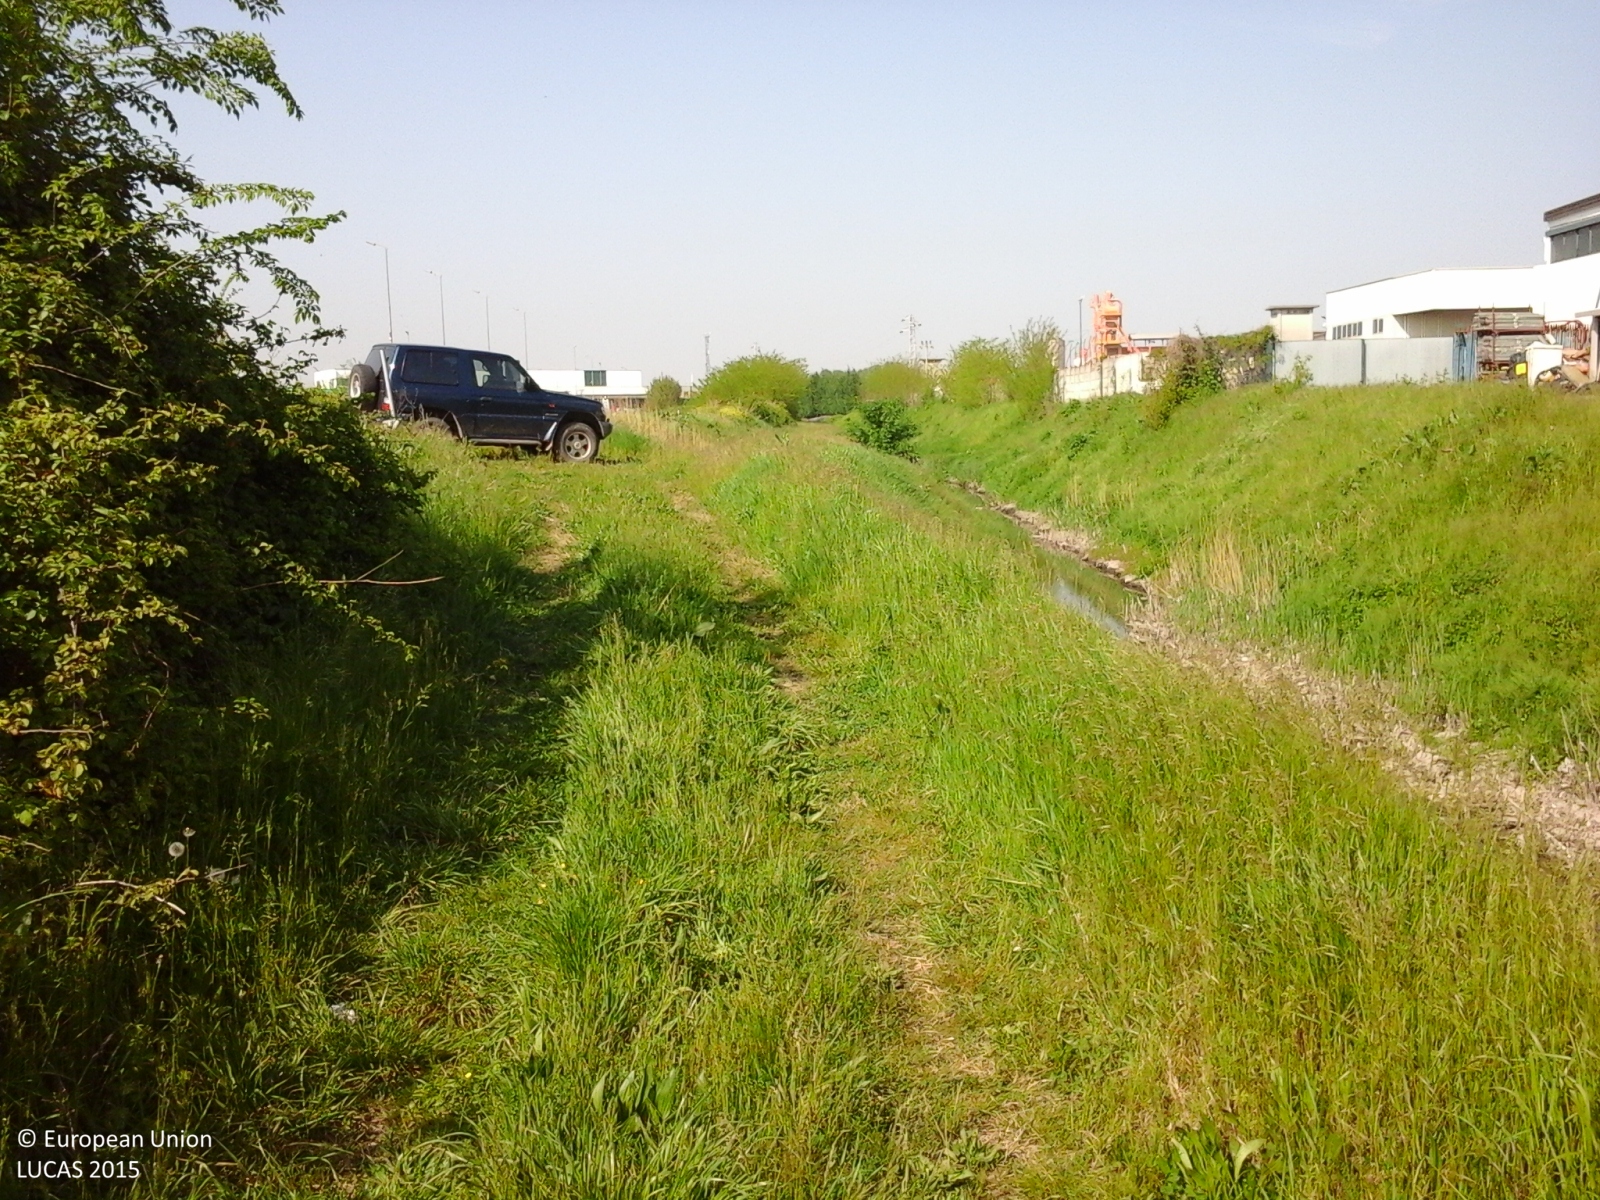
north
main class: Artificial land
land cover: Non built-up linear features
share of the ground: > 75 %
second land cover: Grassland without tree/shrub cover
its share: > 75 %
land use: Road transport
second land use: Community services
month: April
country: IT
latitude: 45.4453
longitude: 12.2083
